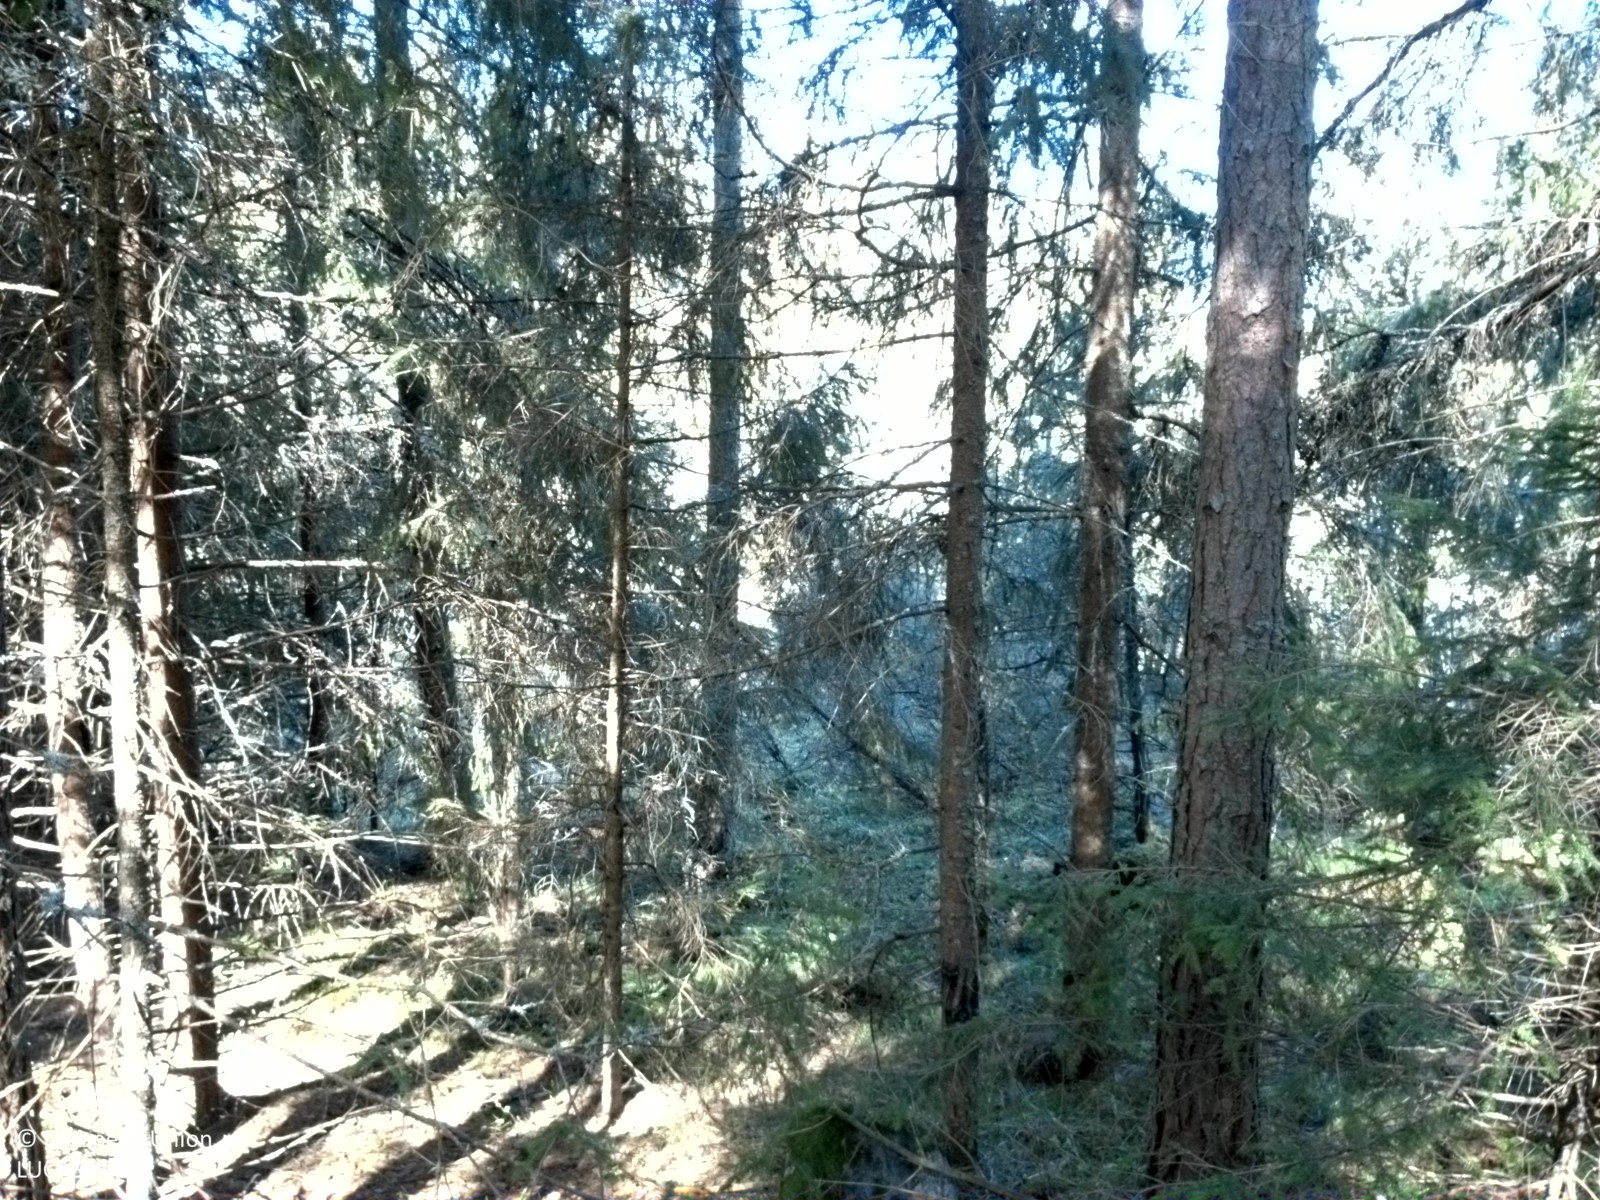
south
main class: Woodland
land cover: Spruce dominated coniferous woodland
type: boreal forest
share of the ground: > 75 %
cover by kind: coniferous forest trees 75 %, lichens and mosses 10 %, herbaceous plants 5 %, consolidated bare surface 5 %
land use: Forestry
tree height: > 5 m
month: May
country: SE
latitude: 60.1361
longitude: 17.9702
